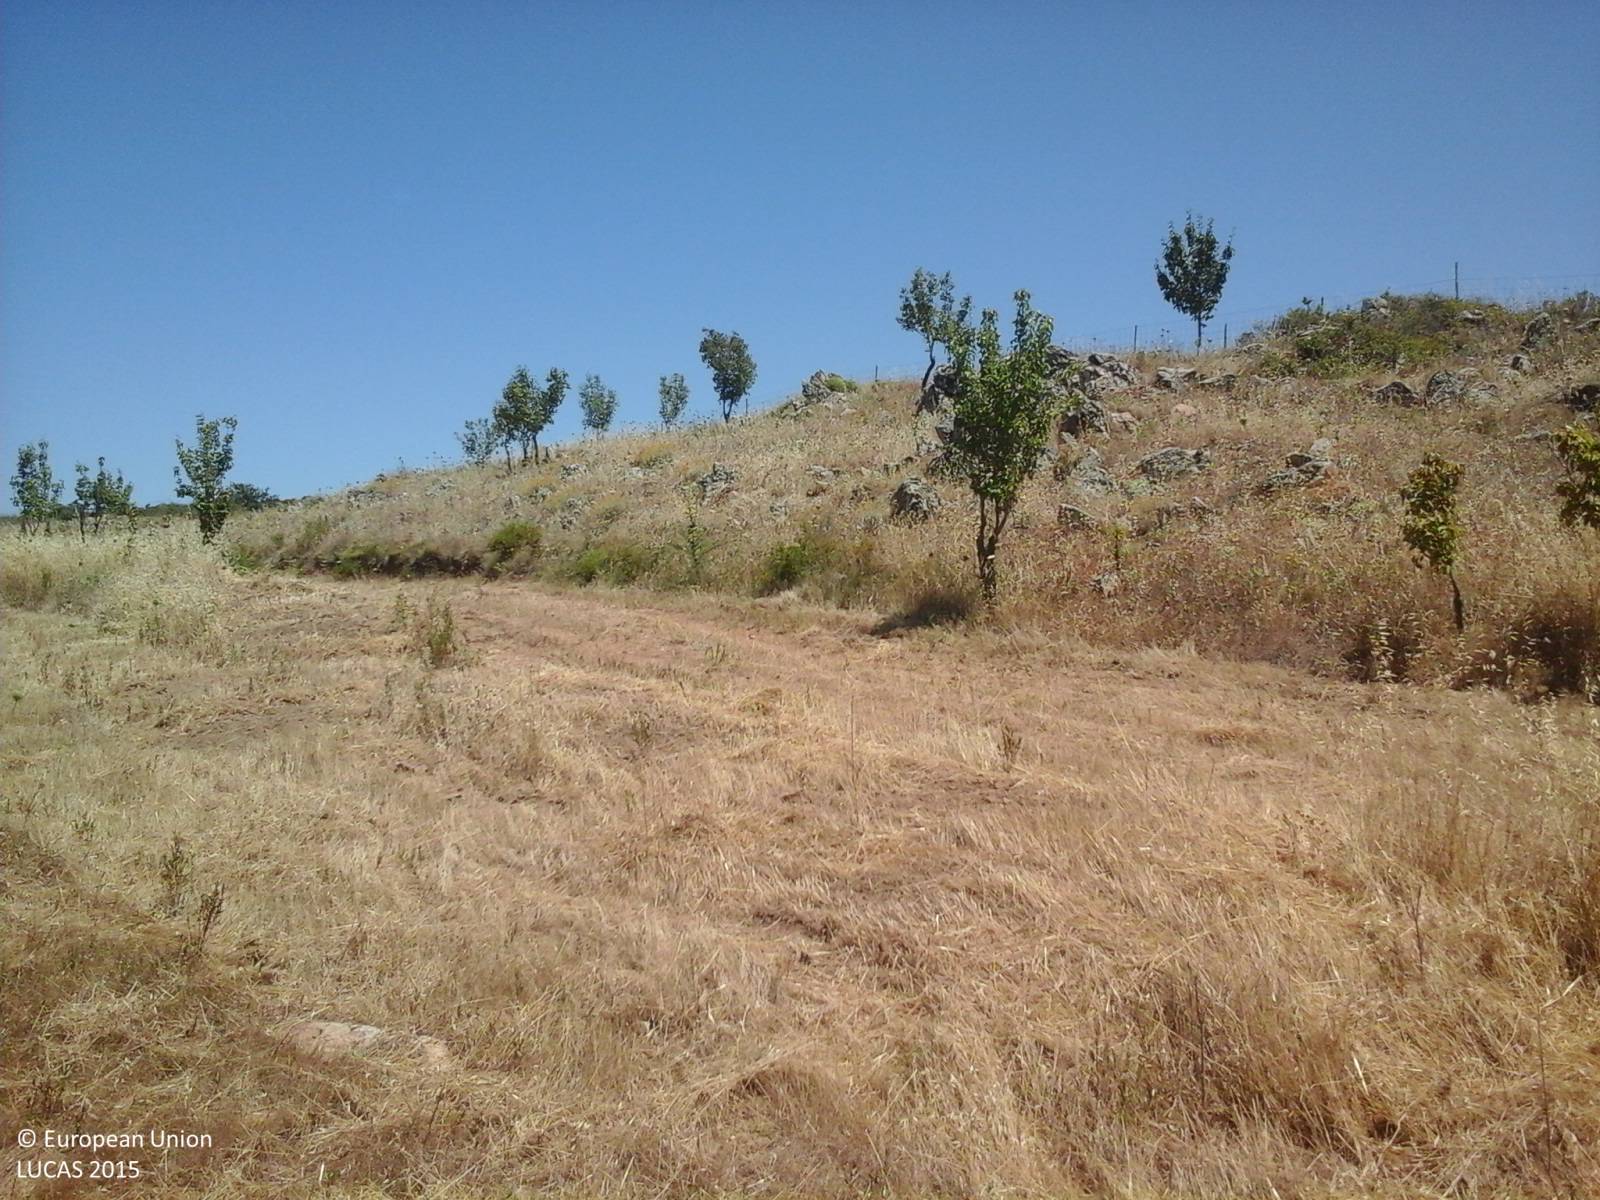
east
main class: Grassland
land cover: Grassland without tree/shrub cover
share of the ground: > 75 %
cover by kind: herbaceous plants 95 %, shrubs 5 %
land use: Agriculture (excluding fallow land and kitchen gardens)
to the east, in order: Grassland without tree/shrub cover; Rocks and stones; Grassland without tree/shrub cover; Fences; Tracks; Grassland without tree/shrub cover; Fences; Grassland without tree/shrub cover; Fences; Grassland without tree/shrub cover; Rocks and stones; Fences; Rocks and stones; Grassland with sparse tree/shrub cover; Fences; Grassland without tree/shrub cover
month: July
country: IT
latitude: 40.5923
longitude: 9.5885
